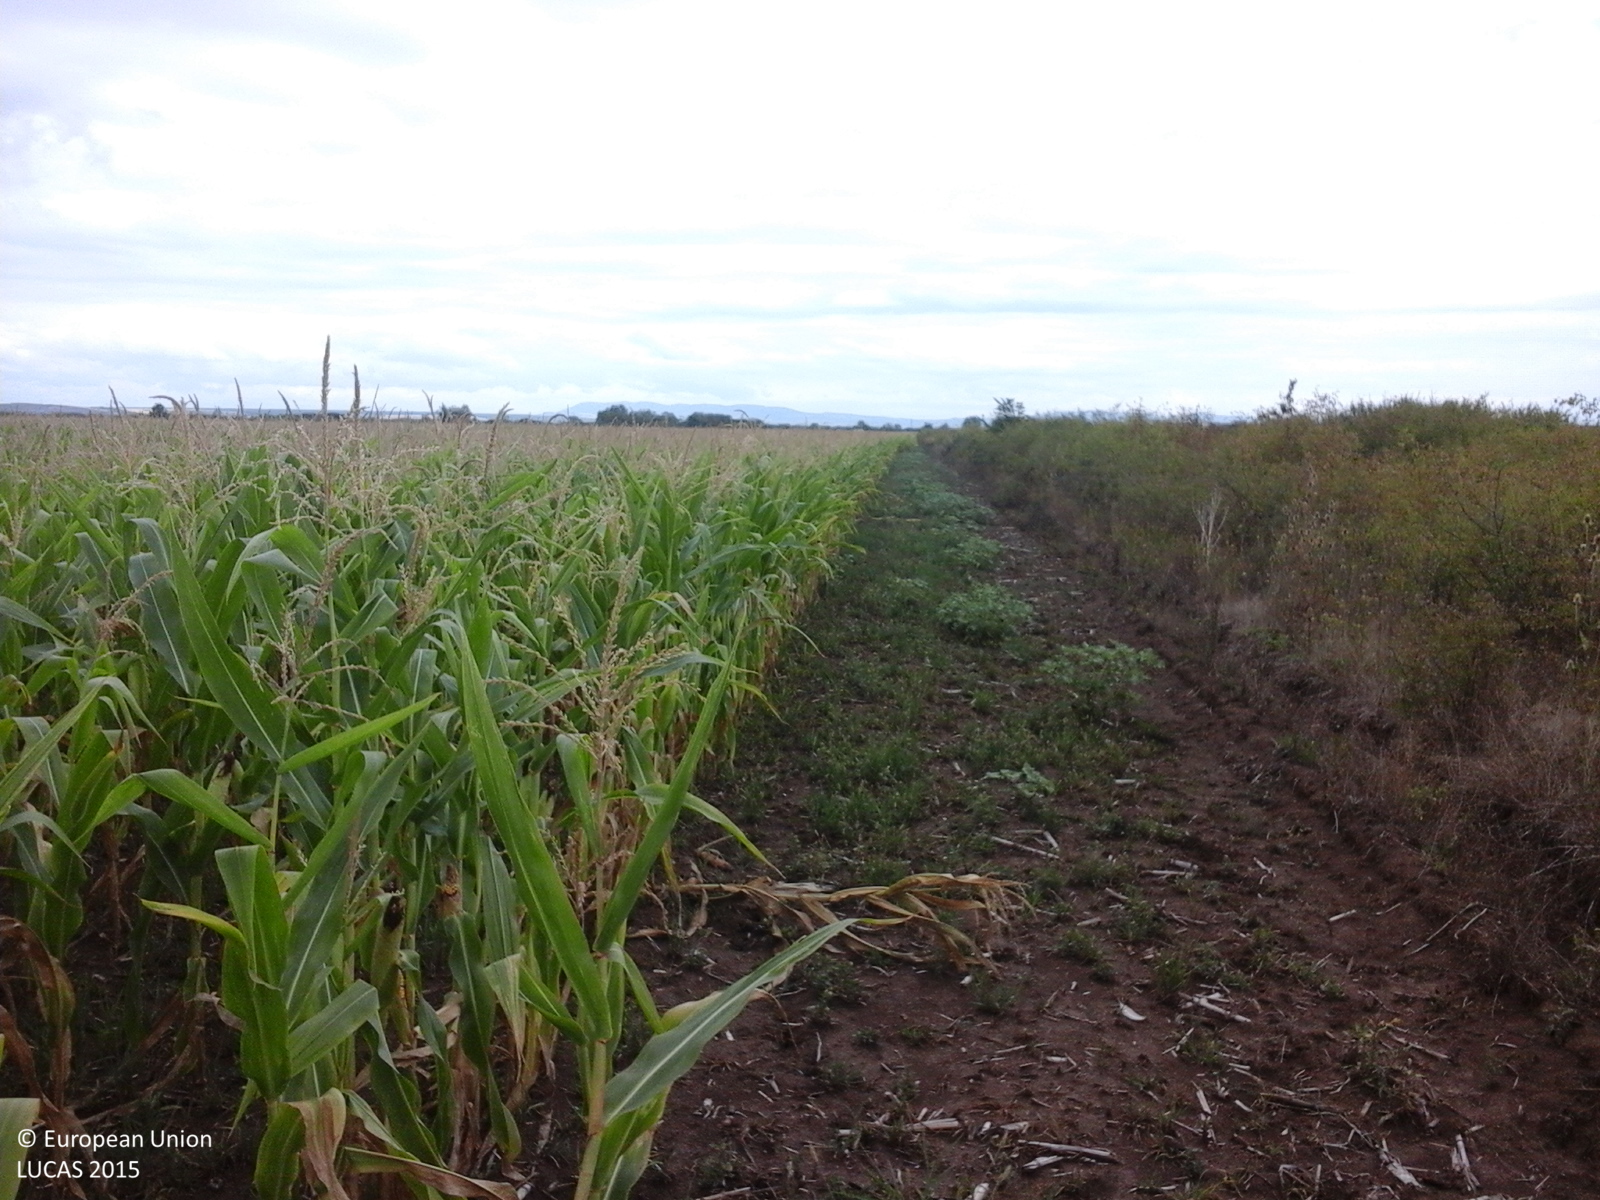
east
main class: Cropland
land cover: Maize
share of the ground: > 75 %
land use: Agriculture (excluding fallow land and kitchen gardens)
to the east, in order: Maize
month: August
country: RO
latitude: 45.4378
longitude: 21.4988
